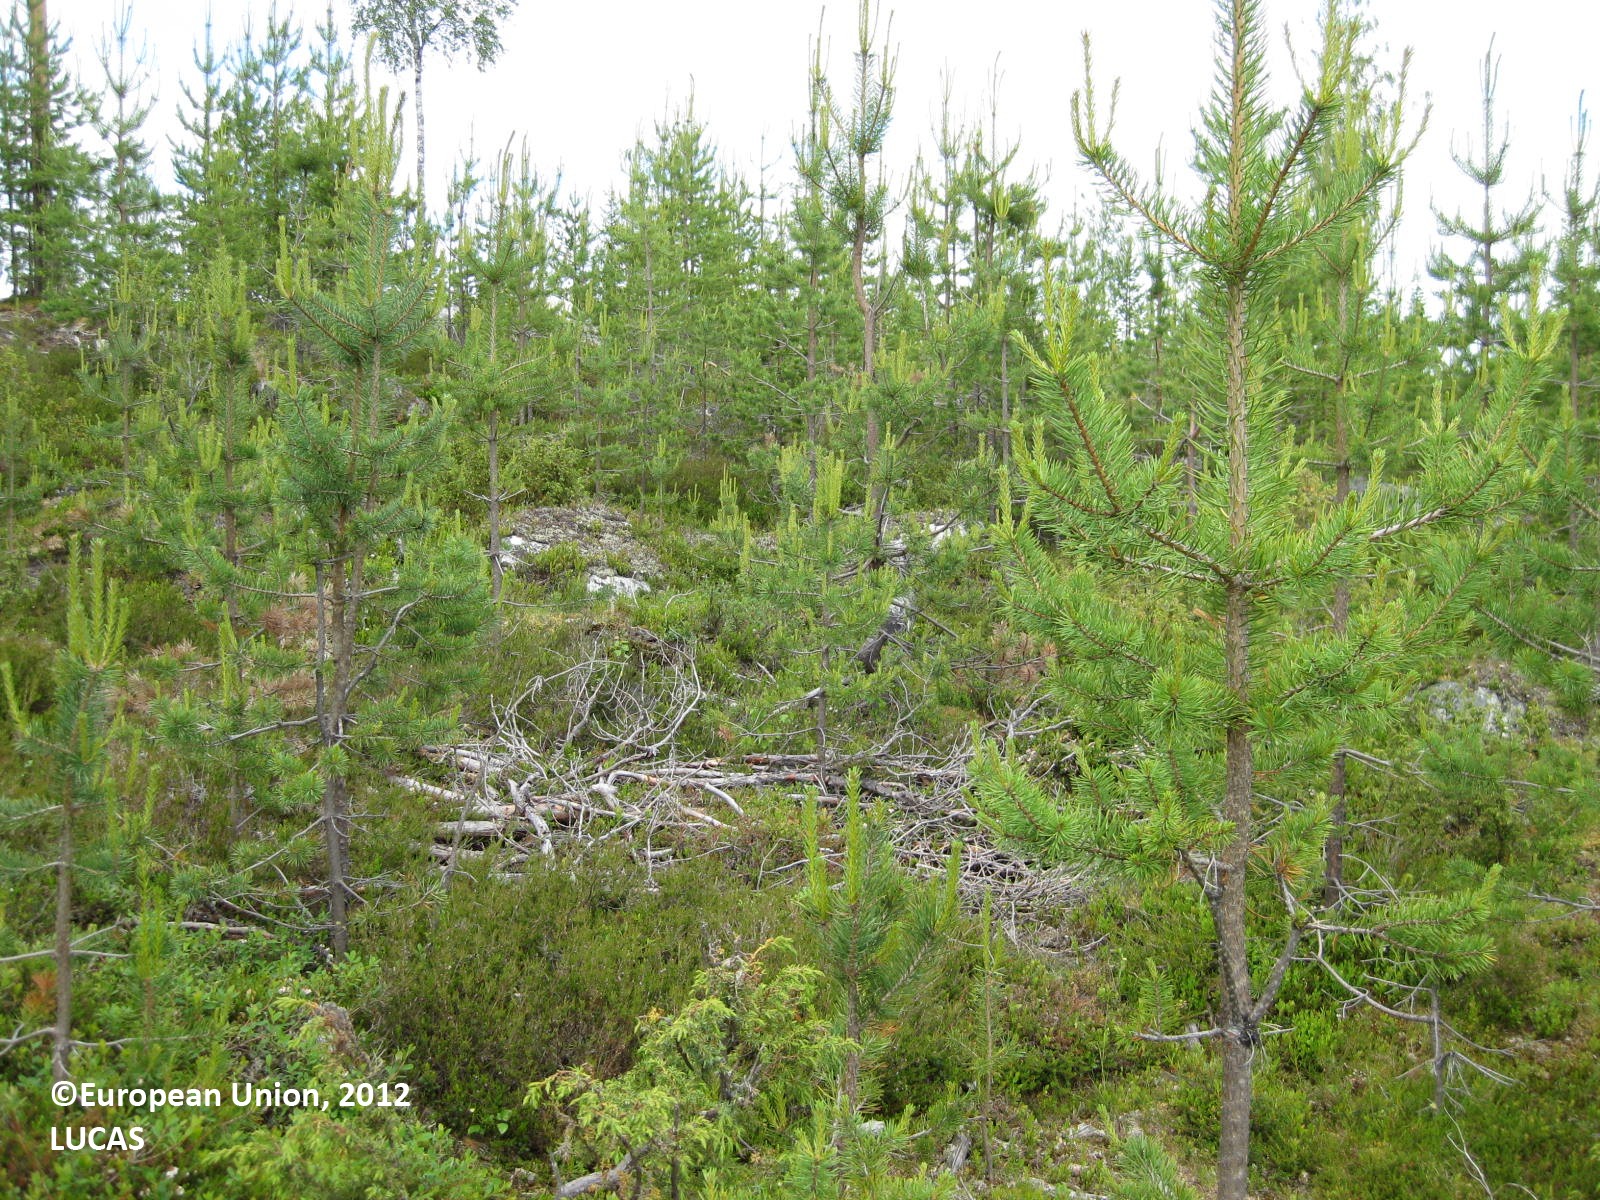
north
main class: Woodland
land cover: Pine dominated coniferous woodland
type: boreal forest
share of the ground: 50 - 75 %
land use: Forestry
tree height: > 5 m
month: July
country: FI
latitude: 65.4805
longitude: 29.3027
